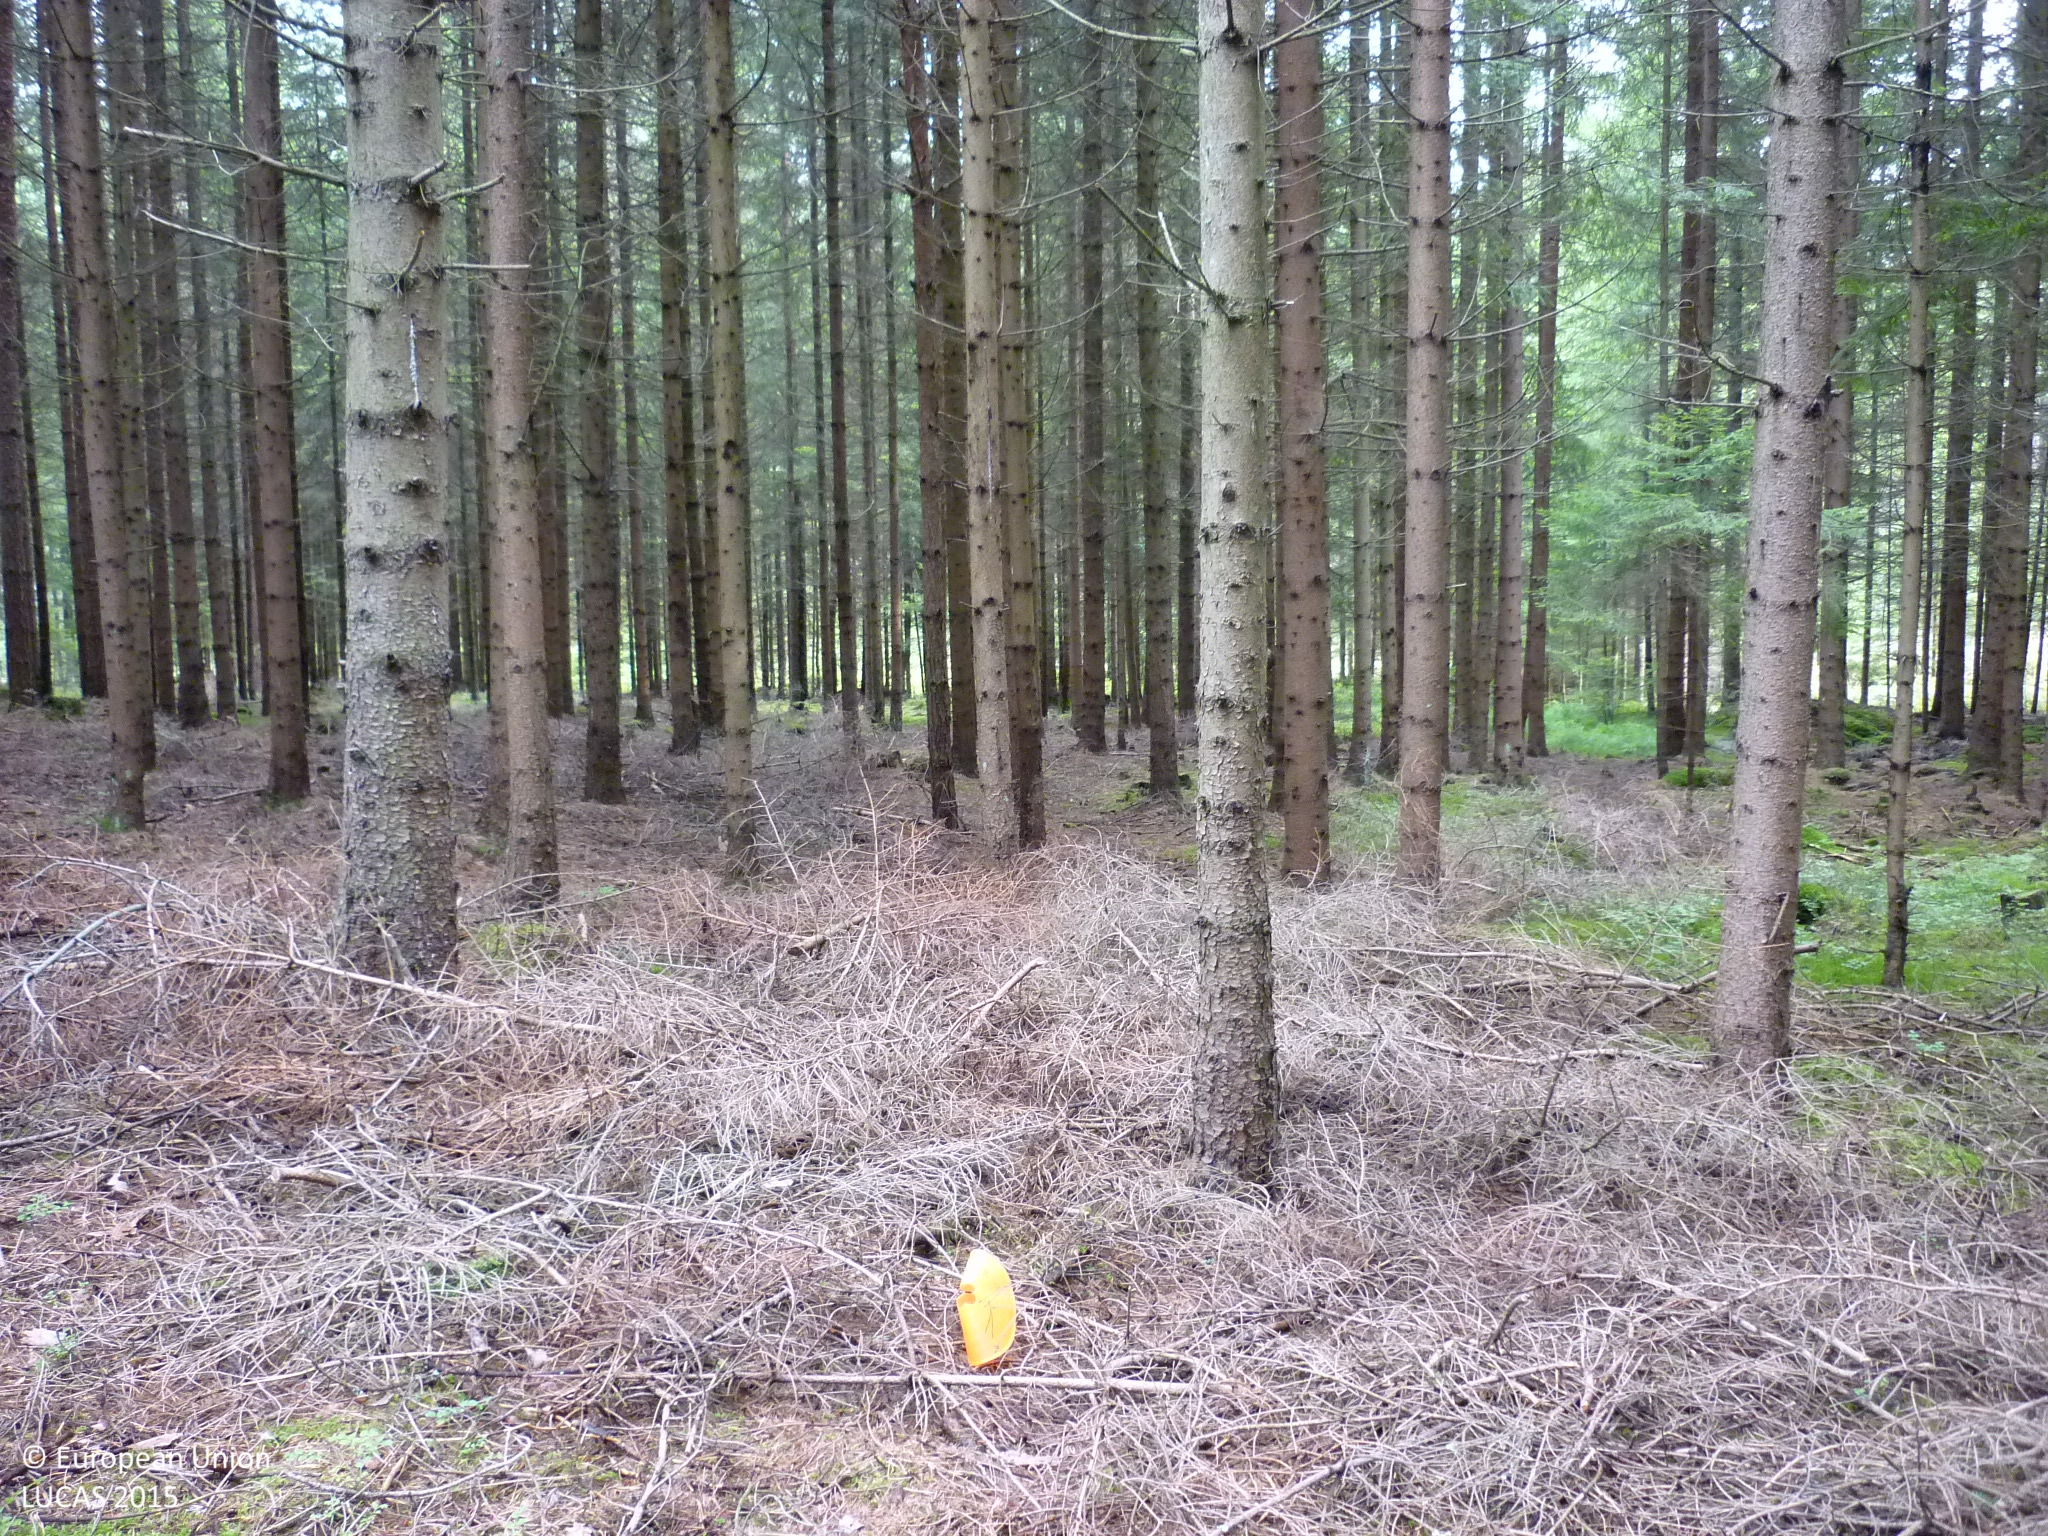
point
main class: Woodland
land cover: Spruce dominated coniferous woodland
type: hemiboreal forest and nemoral coniferous forest and mixed broadleaved-coniferous forest
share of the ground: > 75 %
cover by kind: coniferous forest trees 95 %, lichens and mosses 5 %
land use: Forestry
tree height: > 5 m
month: September
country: AT
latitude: 48.8646
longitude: 15.0595
